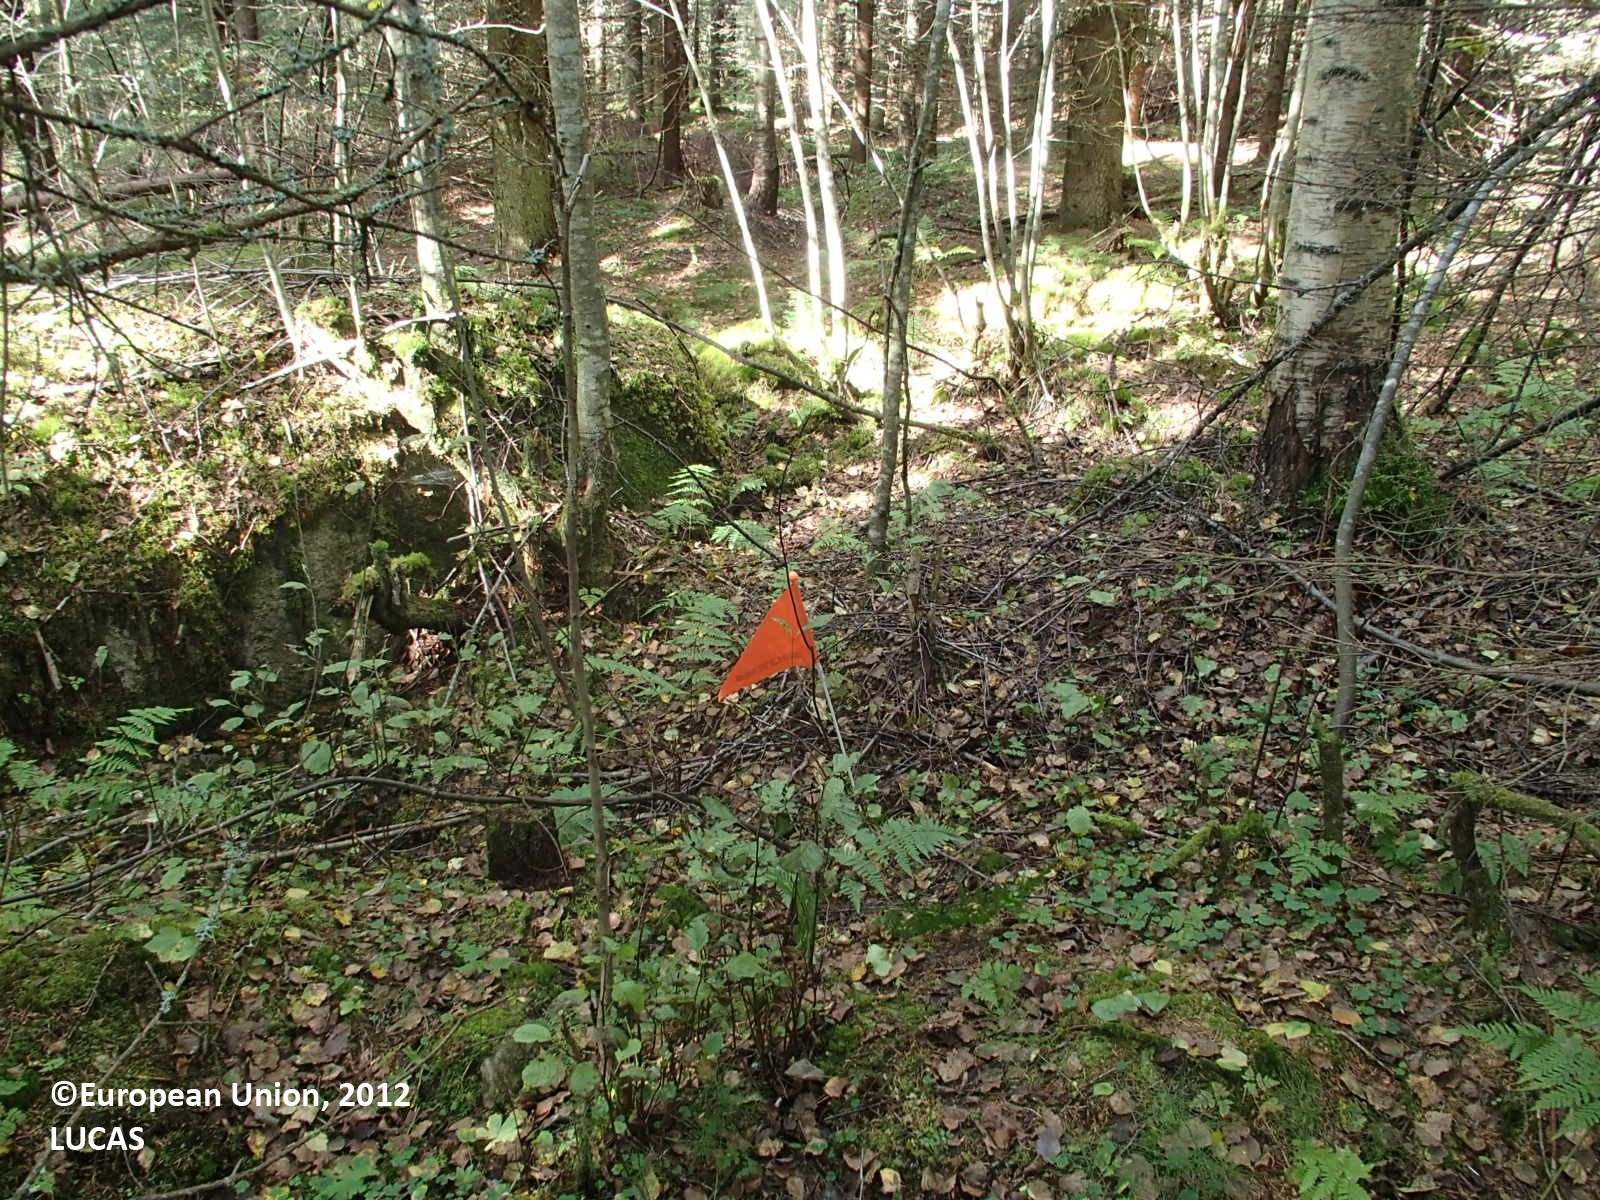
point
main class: Woodland
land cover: Spruce dominated mixed woodland
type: boreal forest
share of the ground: > 75 %
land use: Forestry
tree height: > 5 m
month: August
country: FI
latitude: 63.6292
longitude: 27.0714
